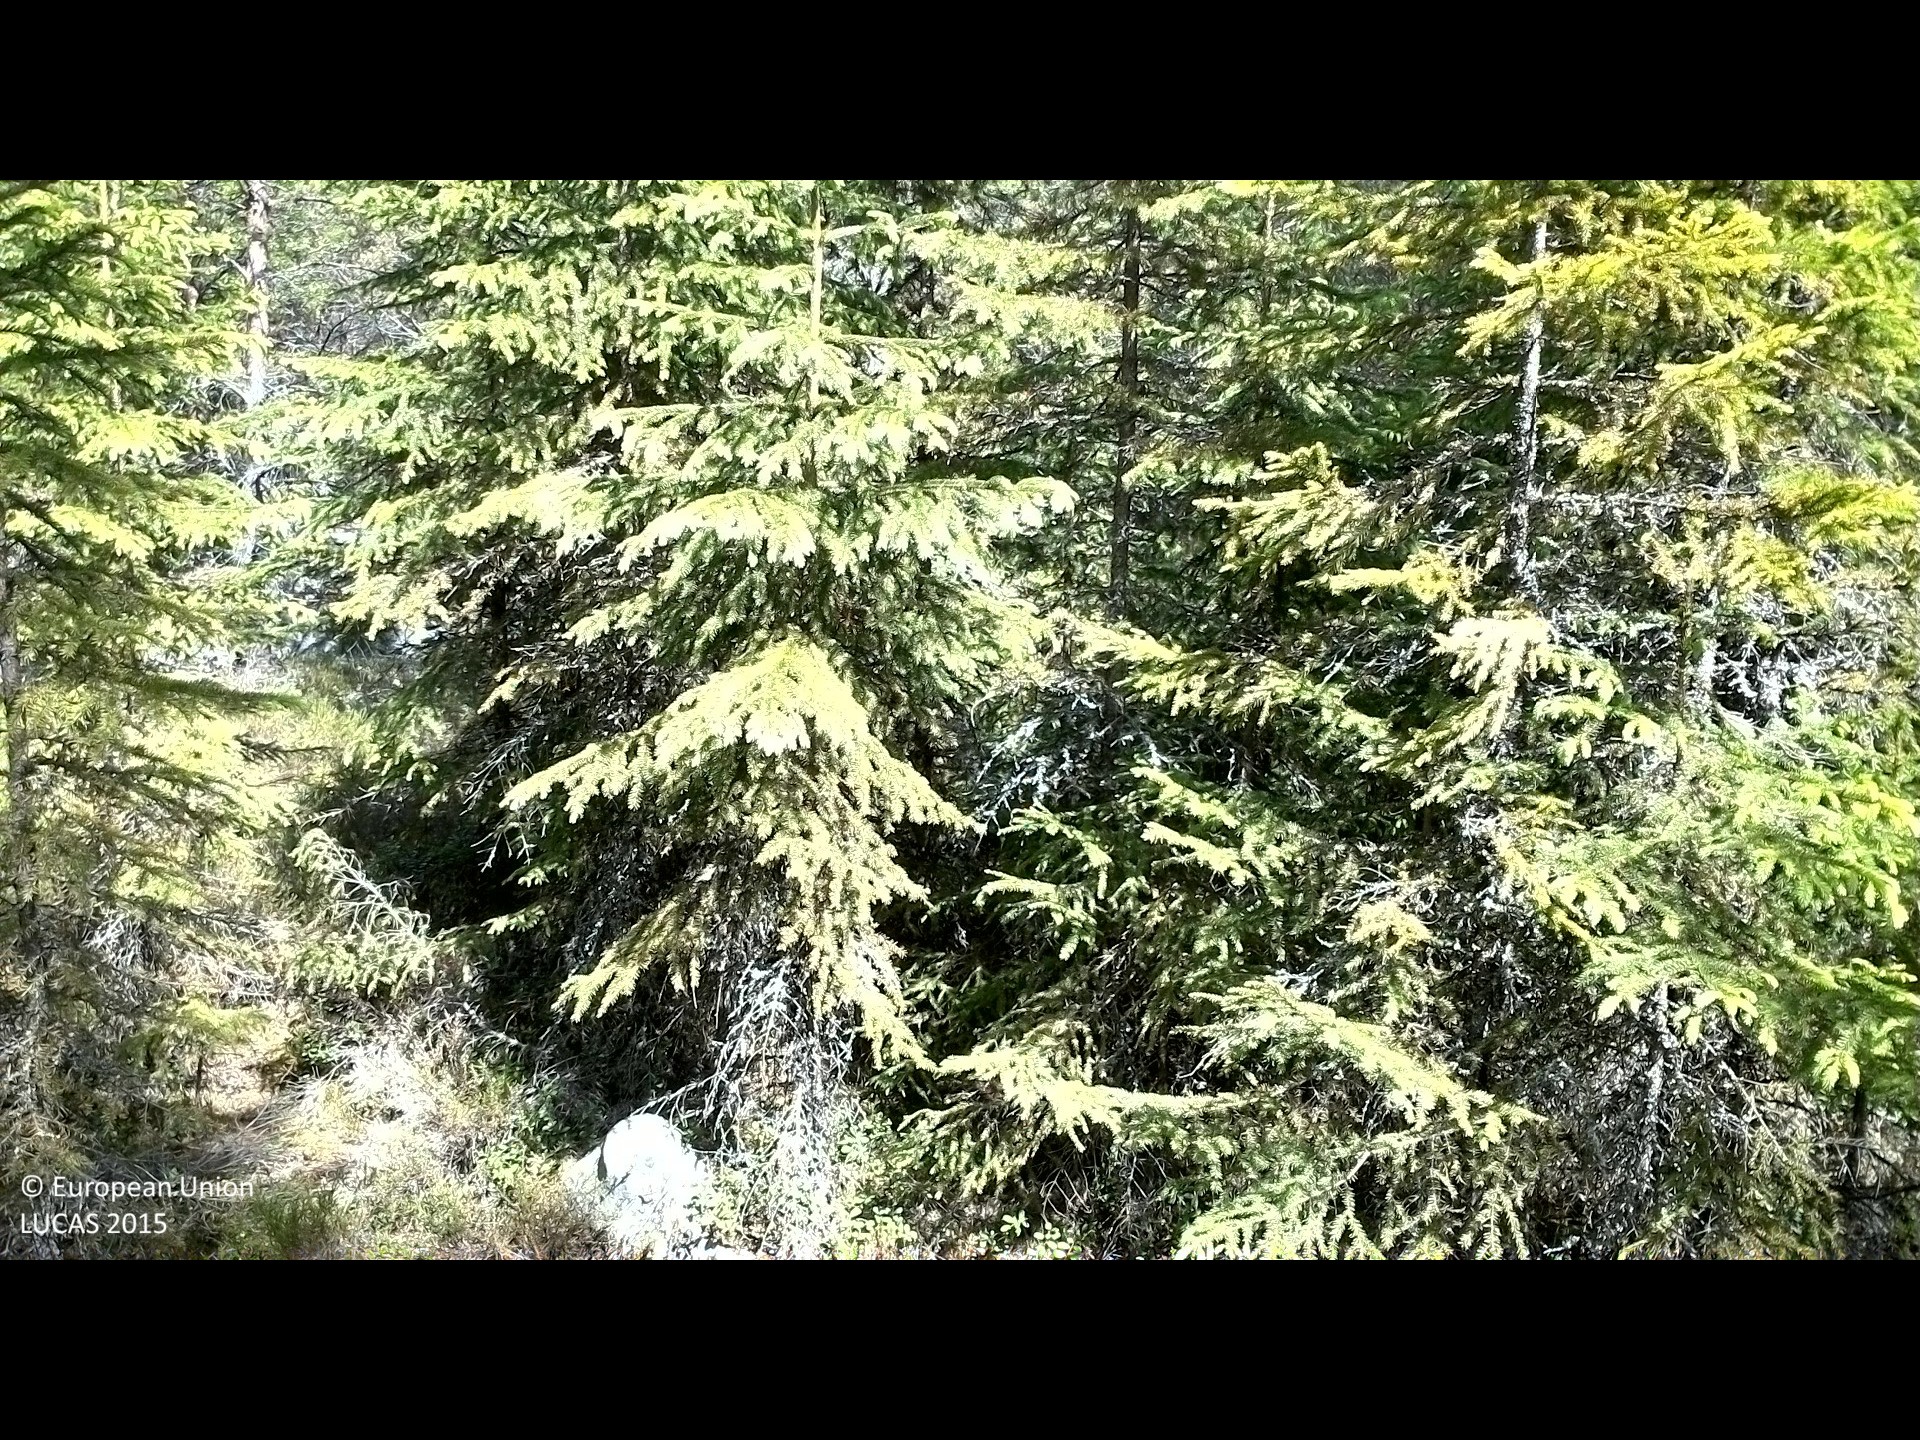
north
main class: Woodland
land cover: Other coniferous woodland
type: boreal forest
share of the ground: 50 - 75 %
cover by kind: coniferous forest trees 45 %, shrubs 30 %, lichens and mosses 15 %, broadleaved forest trees 10 %
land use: Forestry
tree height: > 5 m
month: June
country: SE
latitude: 62.2041
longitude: 17.5749
